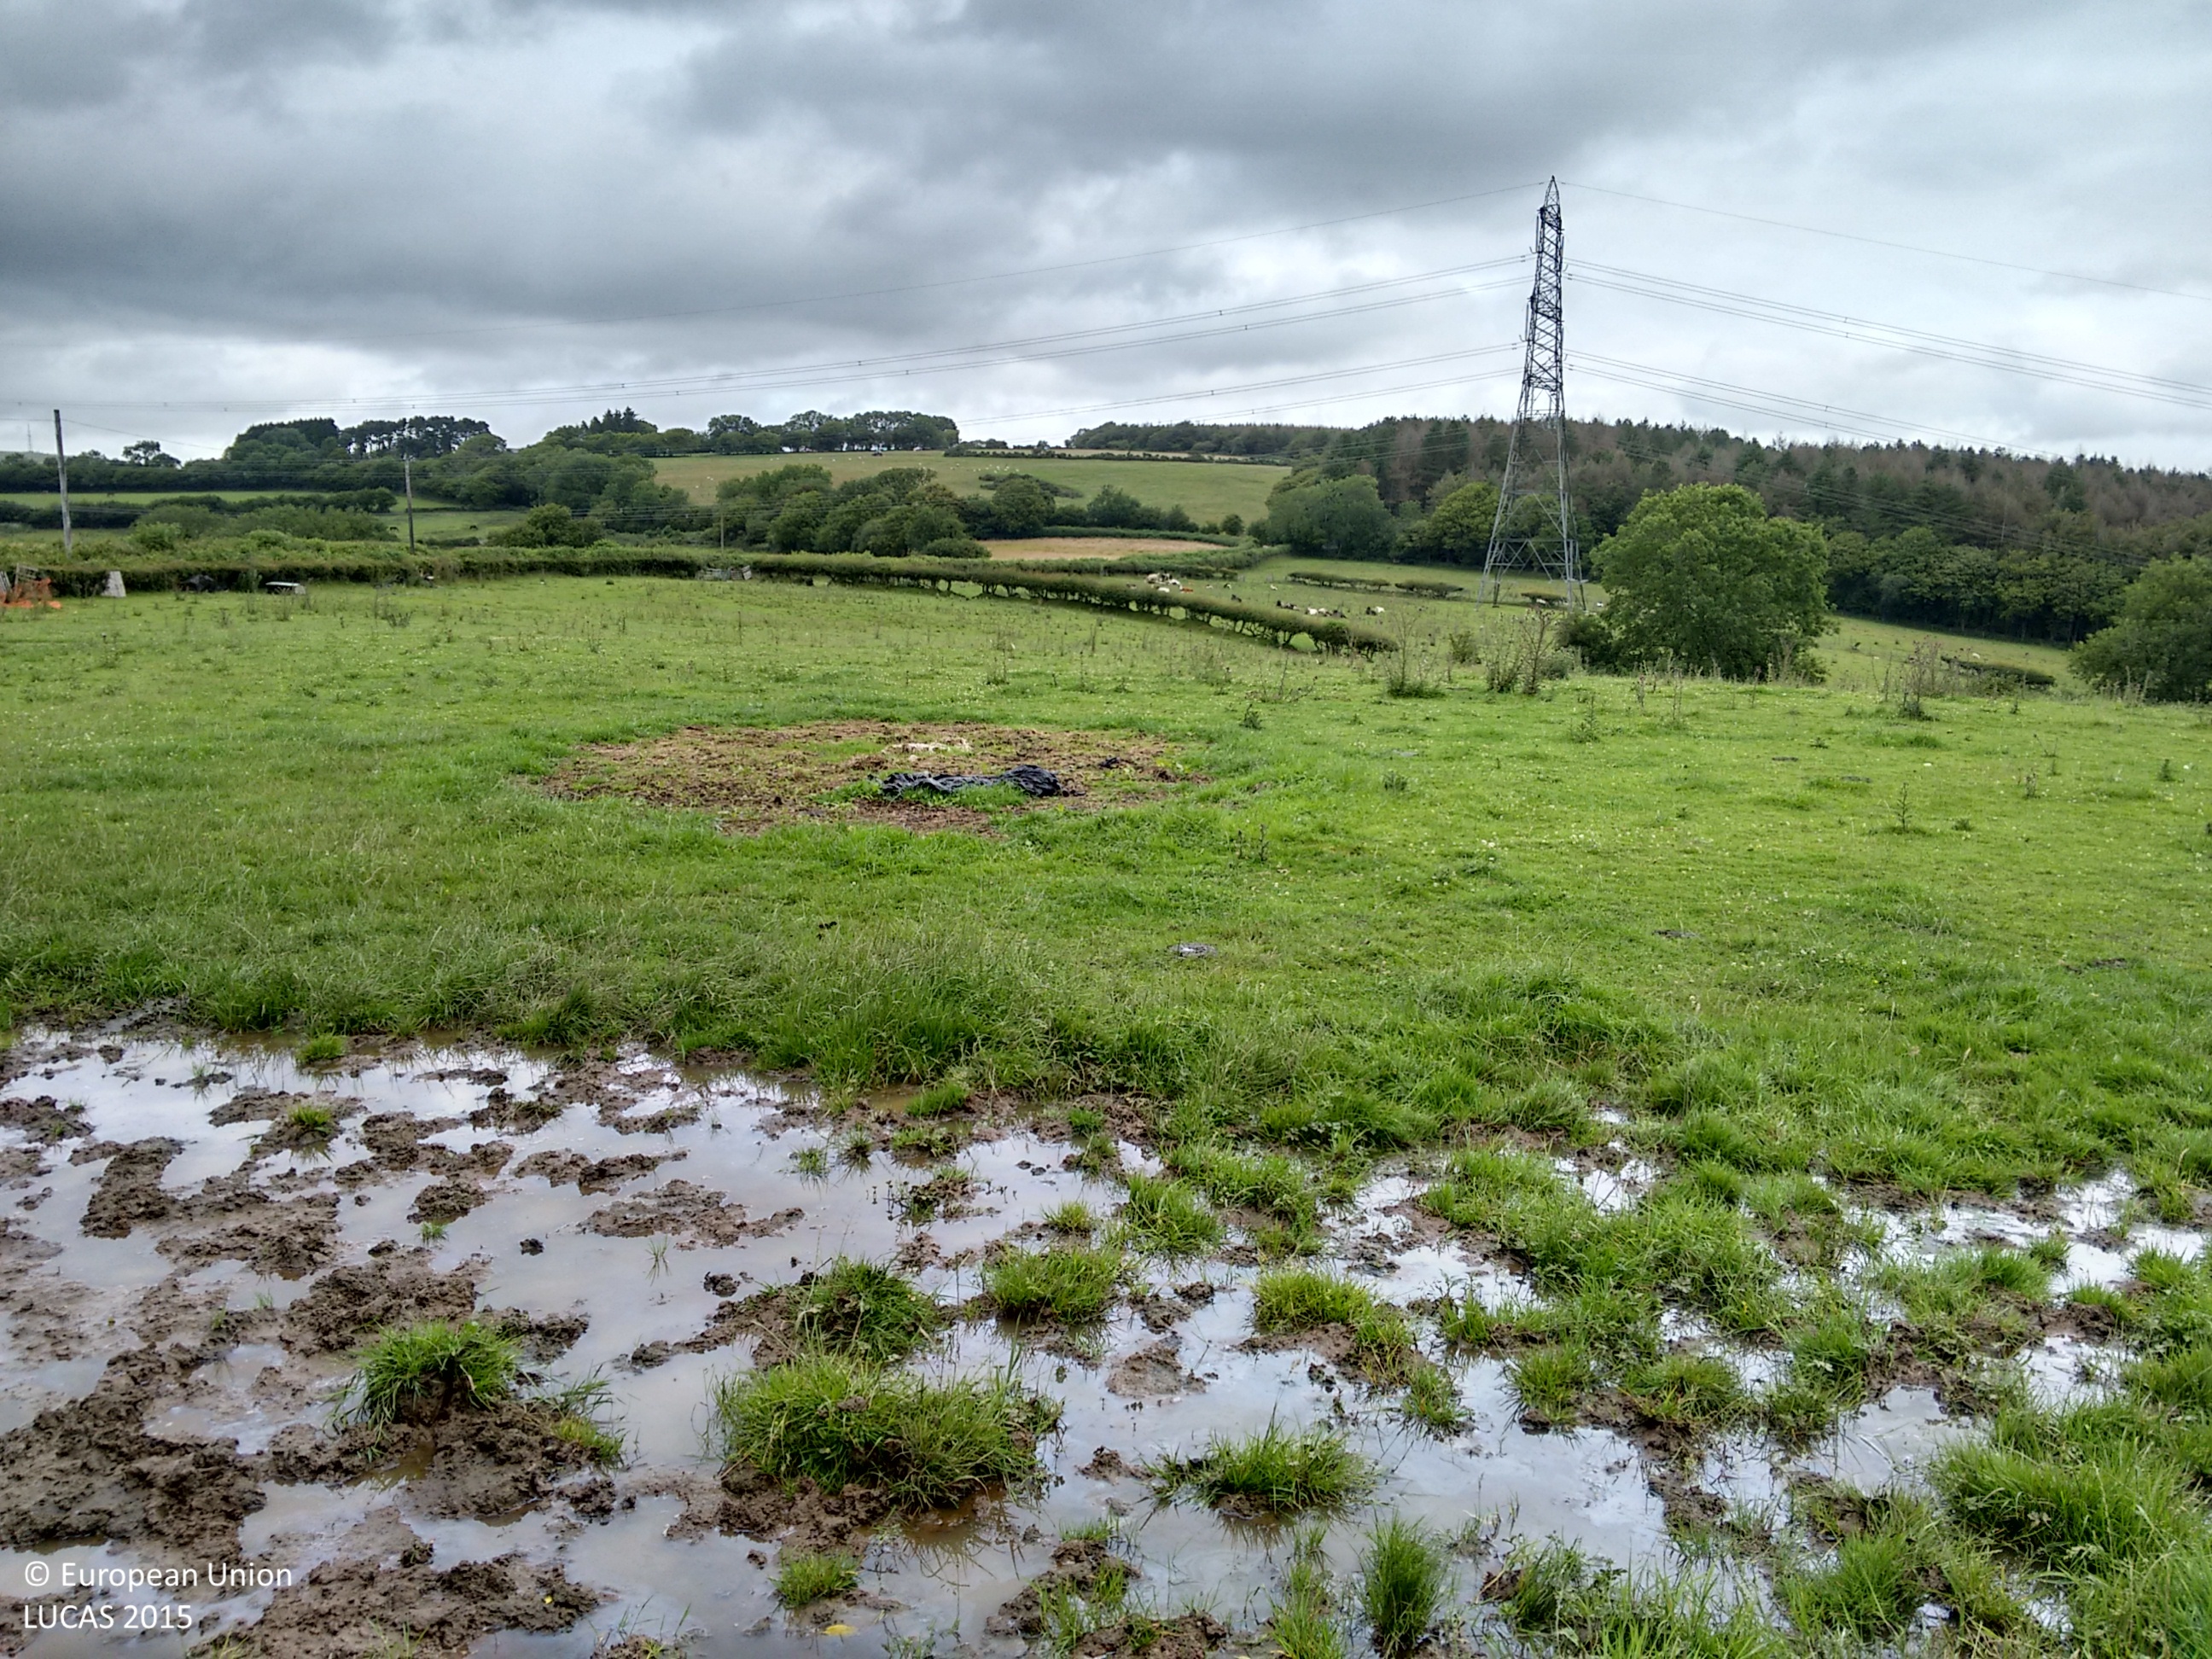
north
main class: Grassland
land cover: Grassland without tree/shrub cover
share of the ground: > 75 %
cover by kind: herbaceous plants 100 %
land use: Agriculture (excluding fallow land and kitchen gardens)
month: July
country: GB
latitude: 51.5568
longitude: -3.5718
